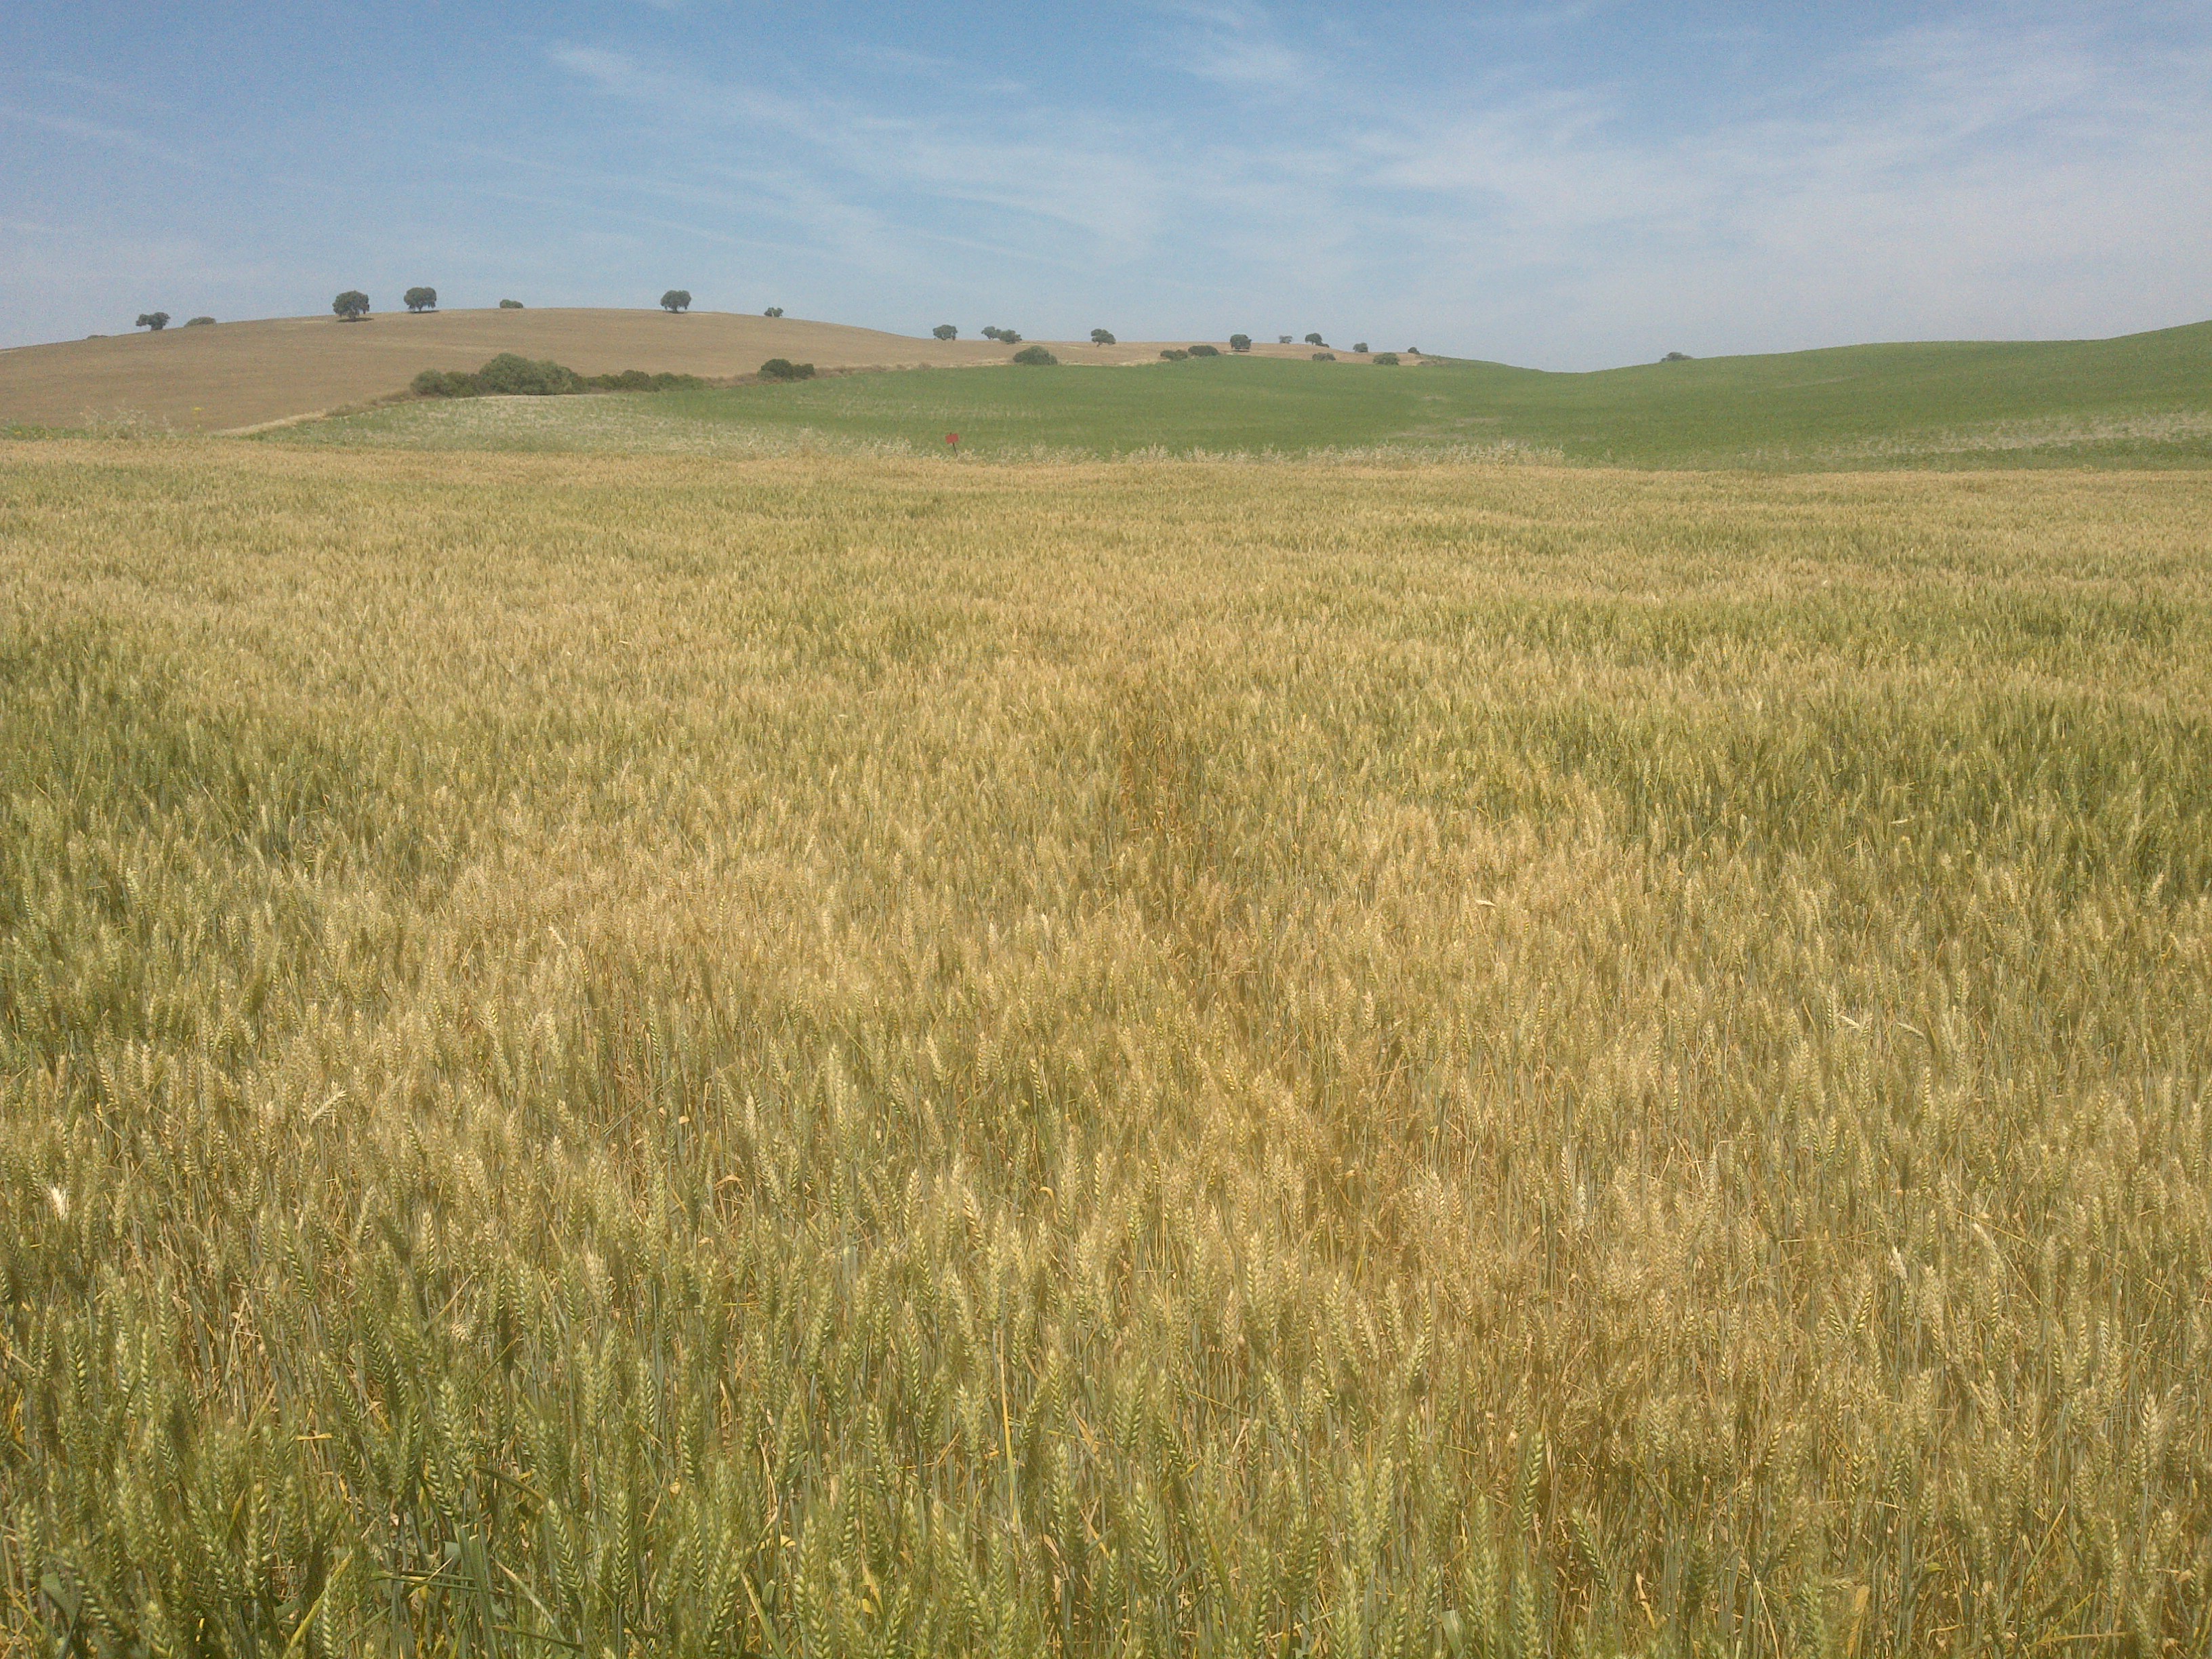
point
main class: Cropland
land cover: Durum wheat
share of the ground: > 75 %
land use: Agriculture (excluding fallow land and kitchen gardens)
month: May
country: ES
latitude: 37.8405
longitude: -4.6364
